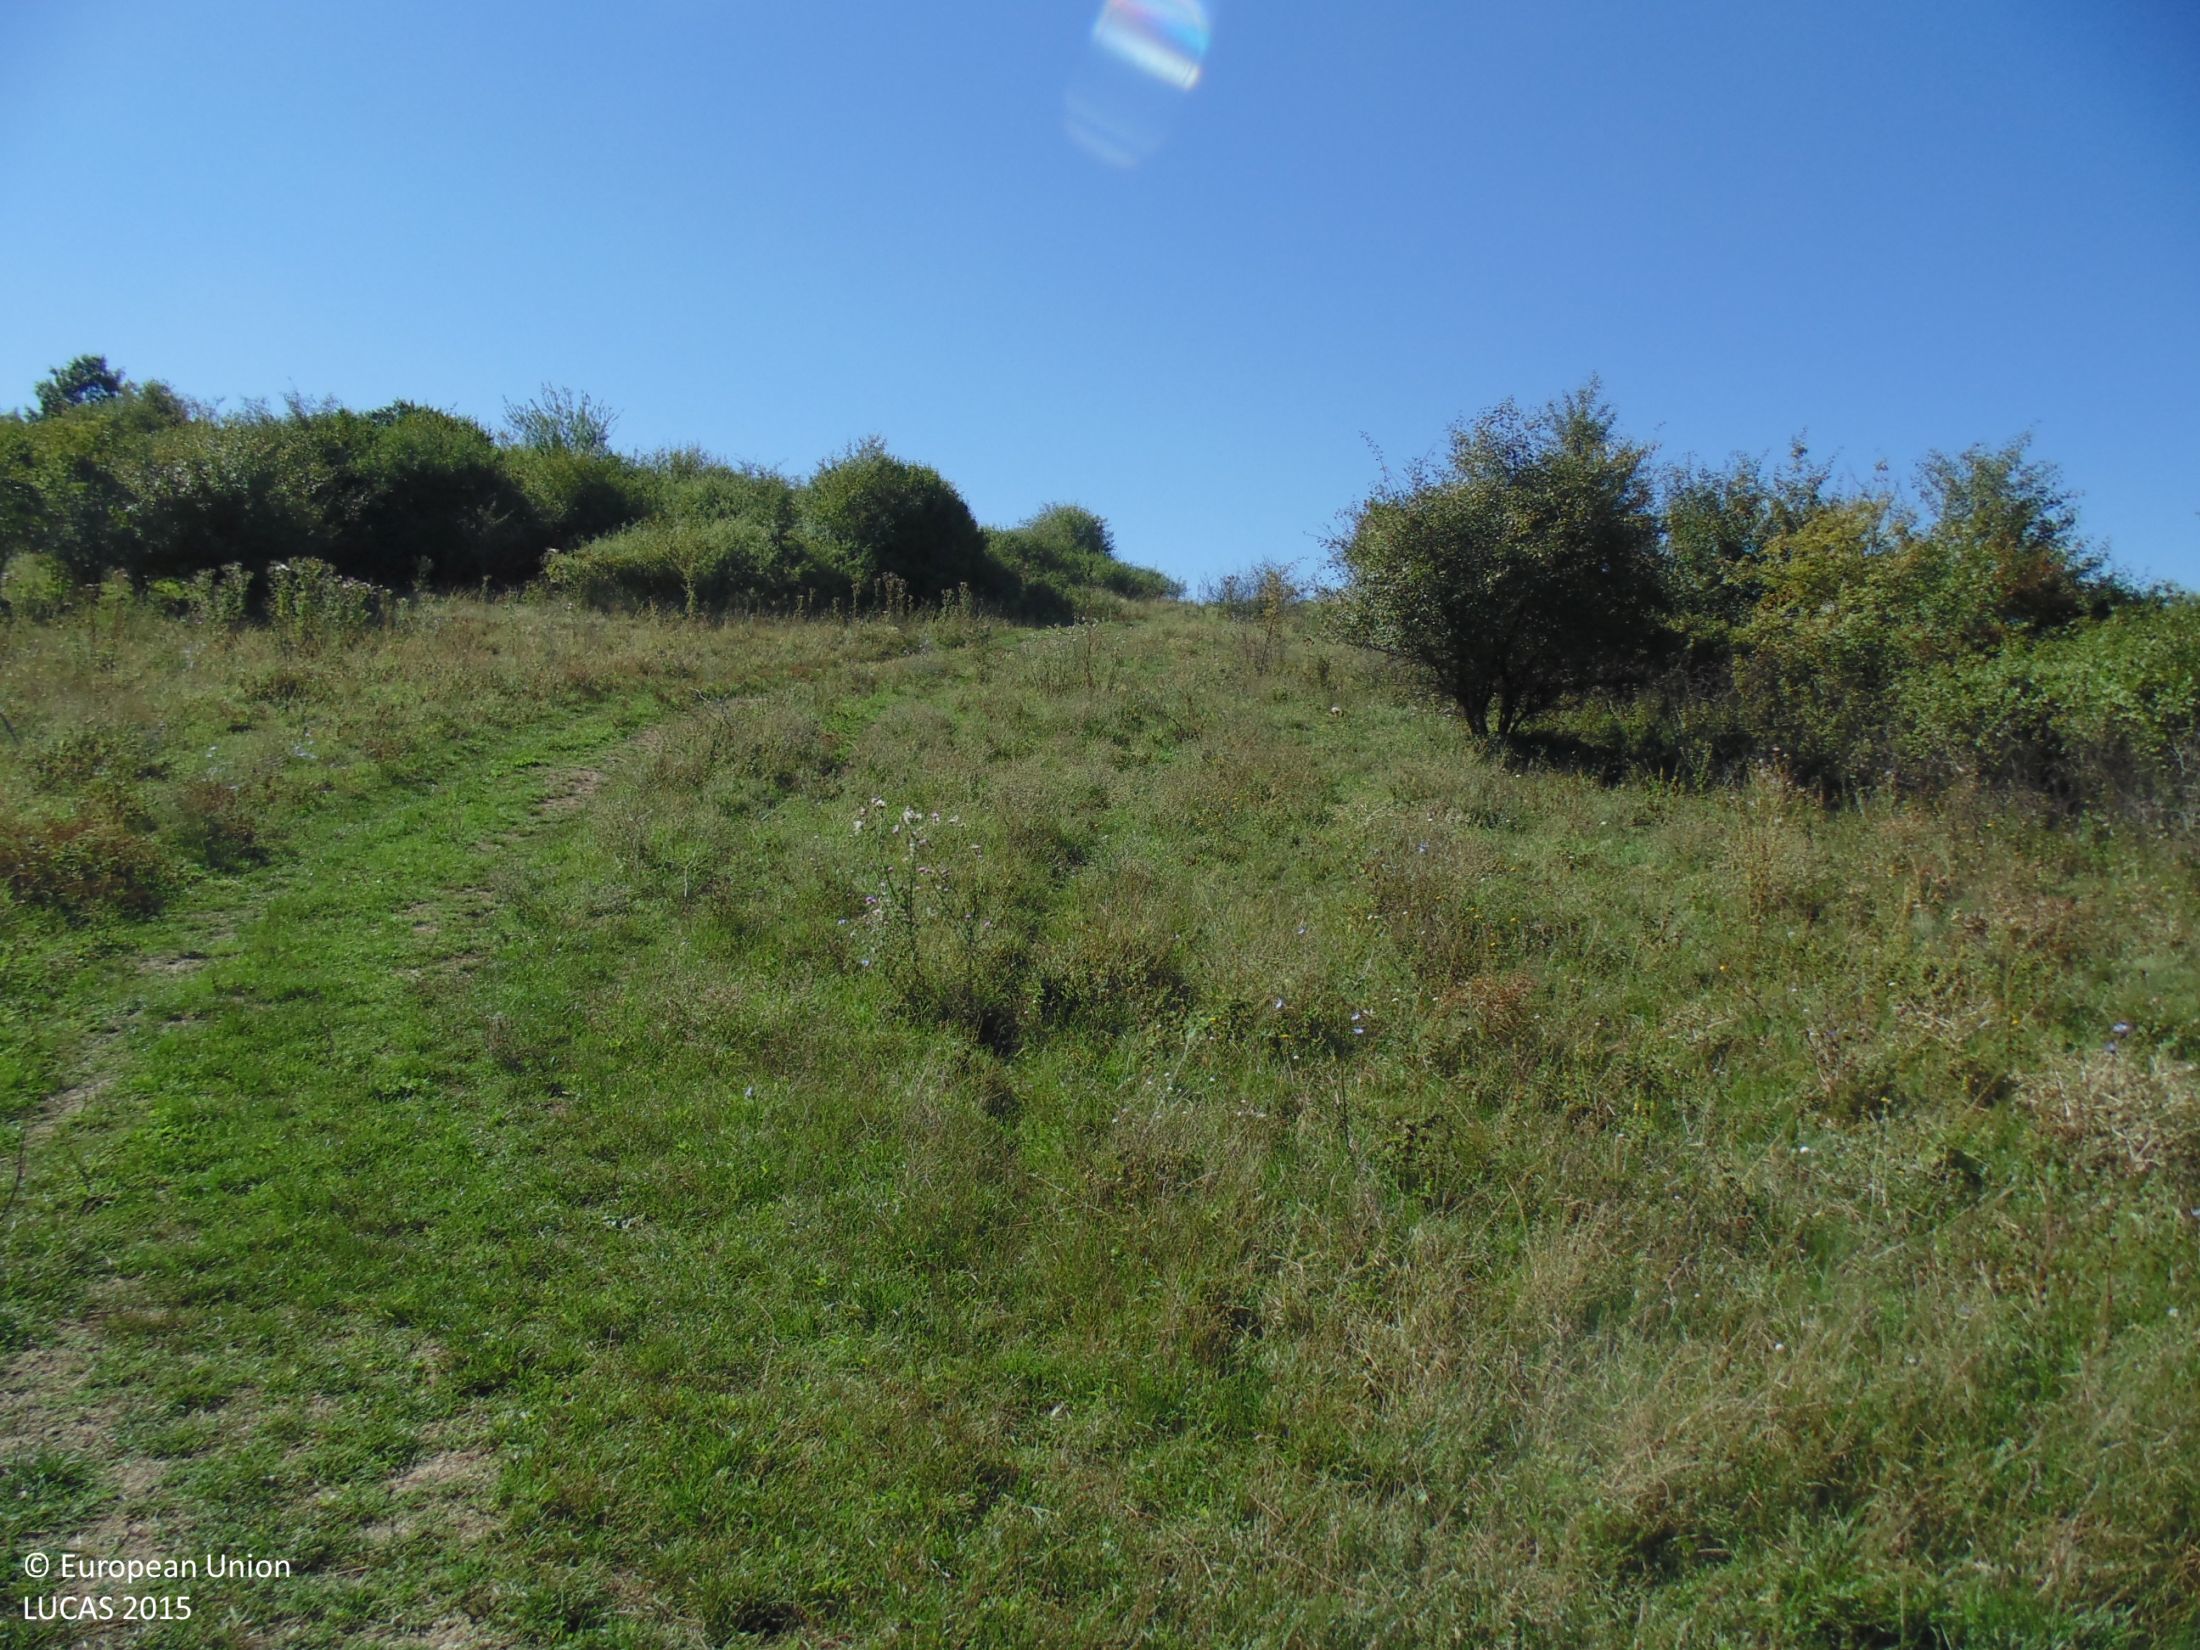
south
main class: Grassland
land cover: Grassland with sparse tree/shrub cover
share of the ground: > 75 %
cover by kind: herbaceous plants 90 %, broadleaved forest trees 5 %, shrubs 5 %
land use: Agriculture (excluding fallow land and kitchen gardens)
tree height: < 5 m
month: September
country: BG
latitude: 43.8013
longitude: 27.3196
